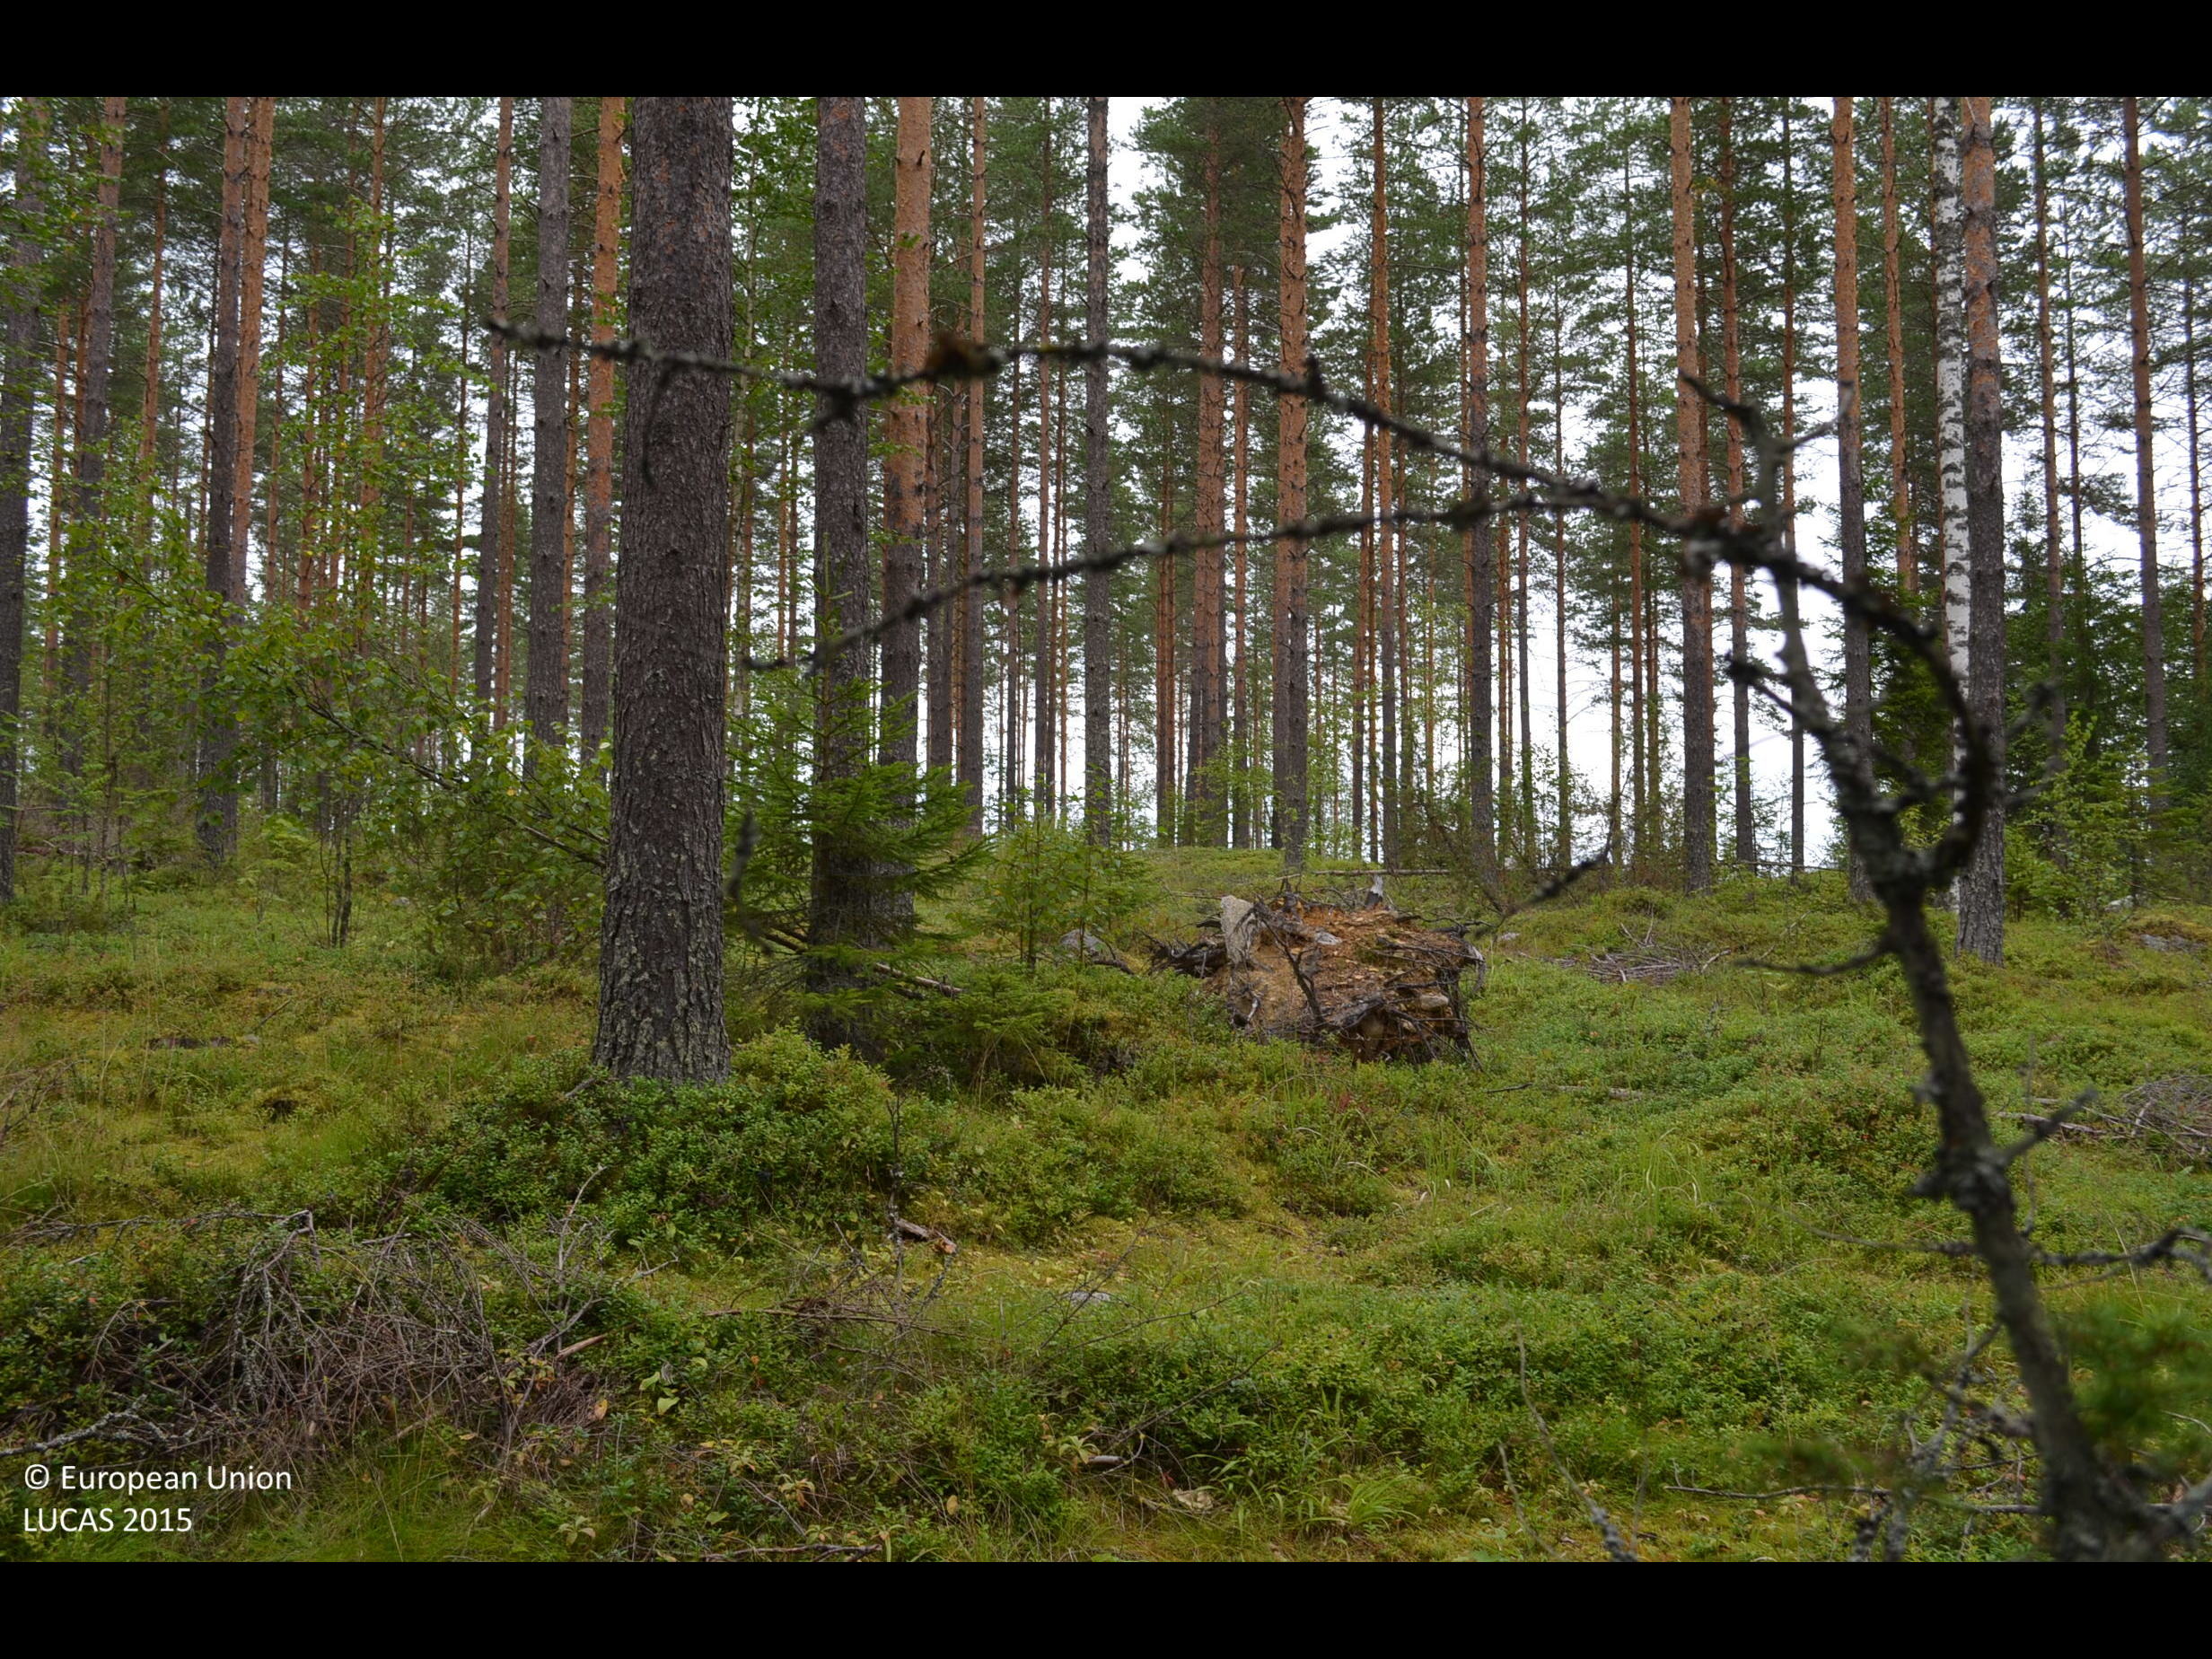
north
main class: Woodland
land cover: Other mixed woodland
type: boreal forest
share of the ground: > 75 %
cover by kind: coniferous forest trees 60 %, broadleaved forest trees 20 %, shrubs 15 %, lichens and mosses 5 %
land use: Forestry
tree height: > 5 m
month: August
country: FI
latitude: 62.2153
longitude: 24.3381
